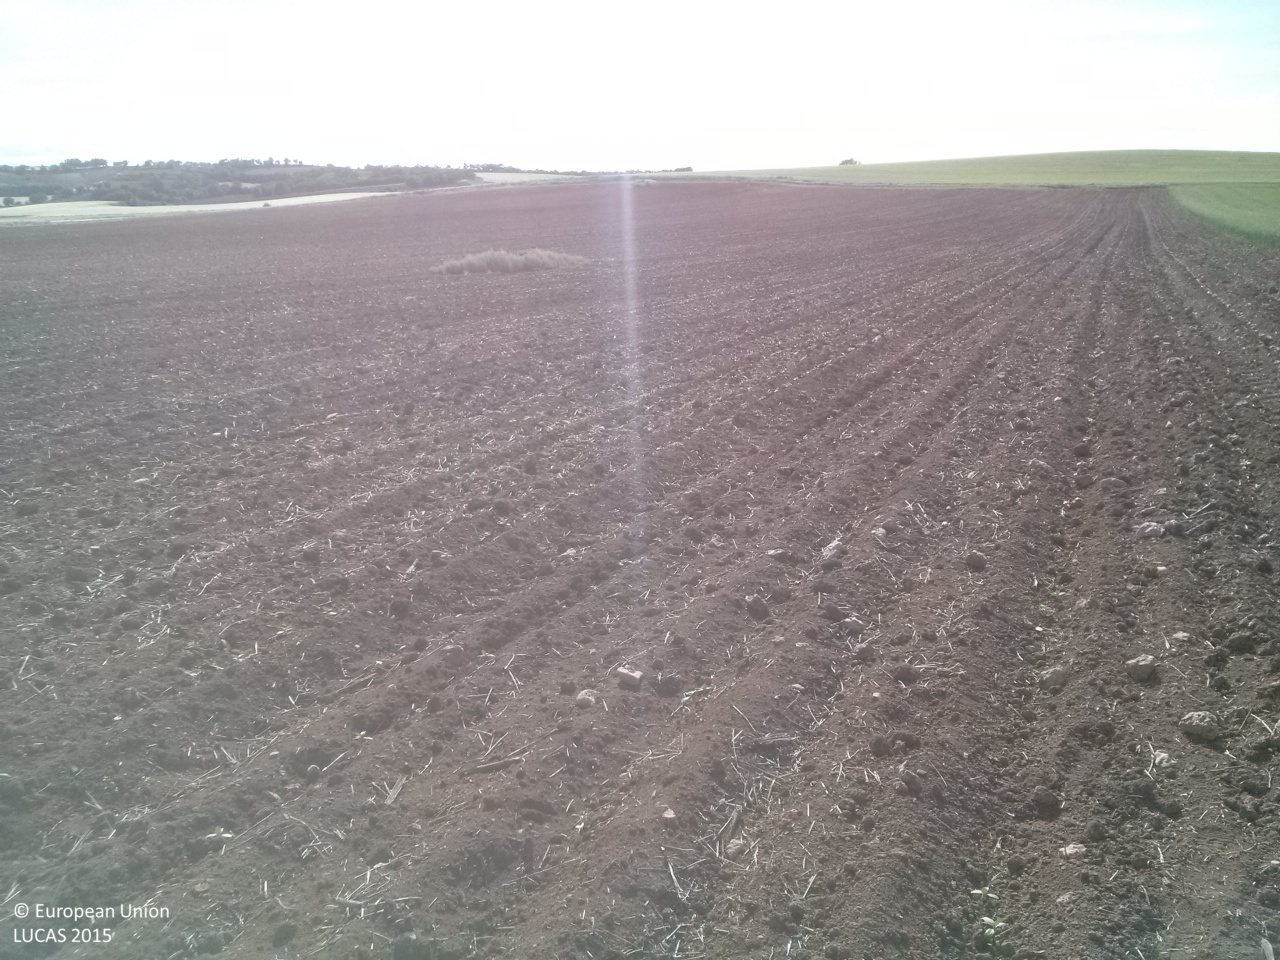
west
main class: Cropland
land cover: Sunflower
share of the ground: < 10 %
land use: Agriculture (excluding fallow land and kitchen gardens)
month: May
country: ES
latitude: 40.0758
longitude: -2.7210
